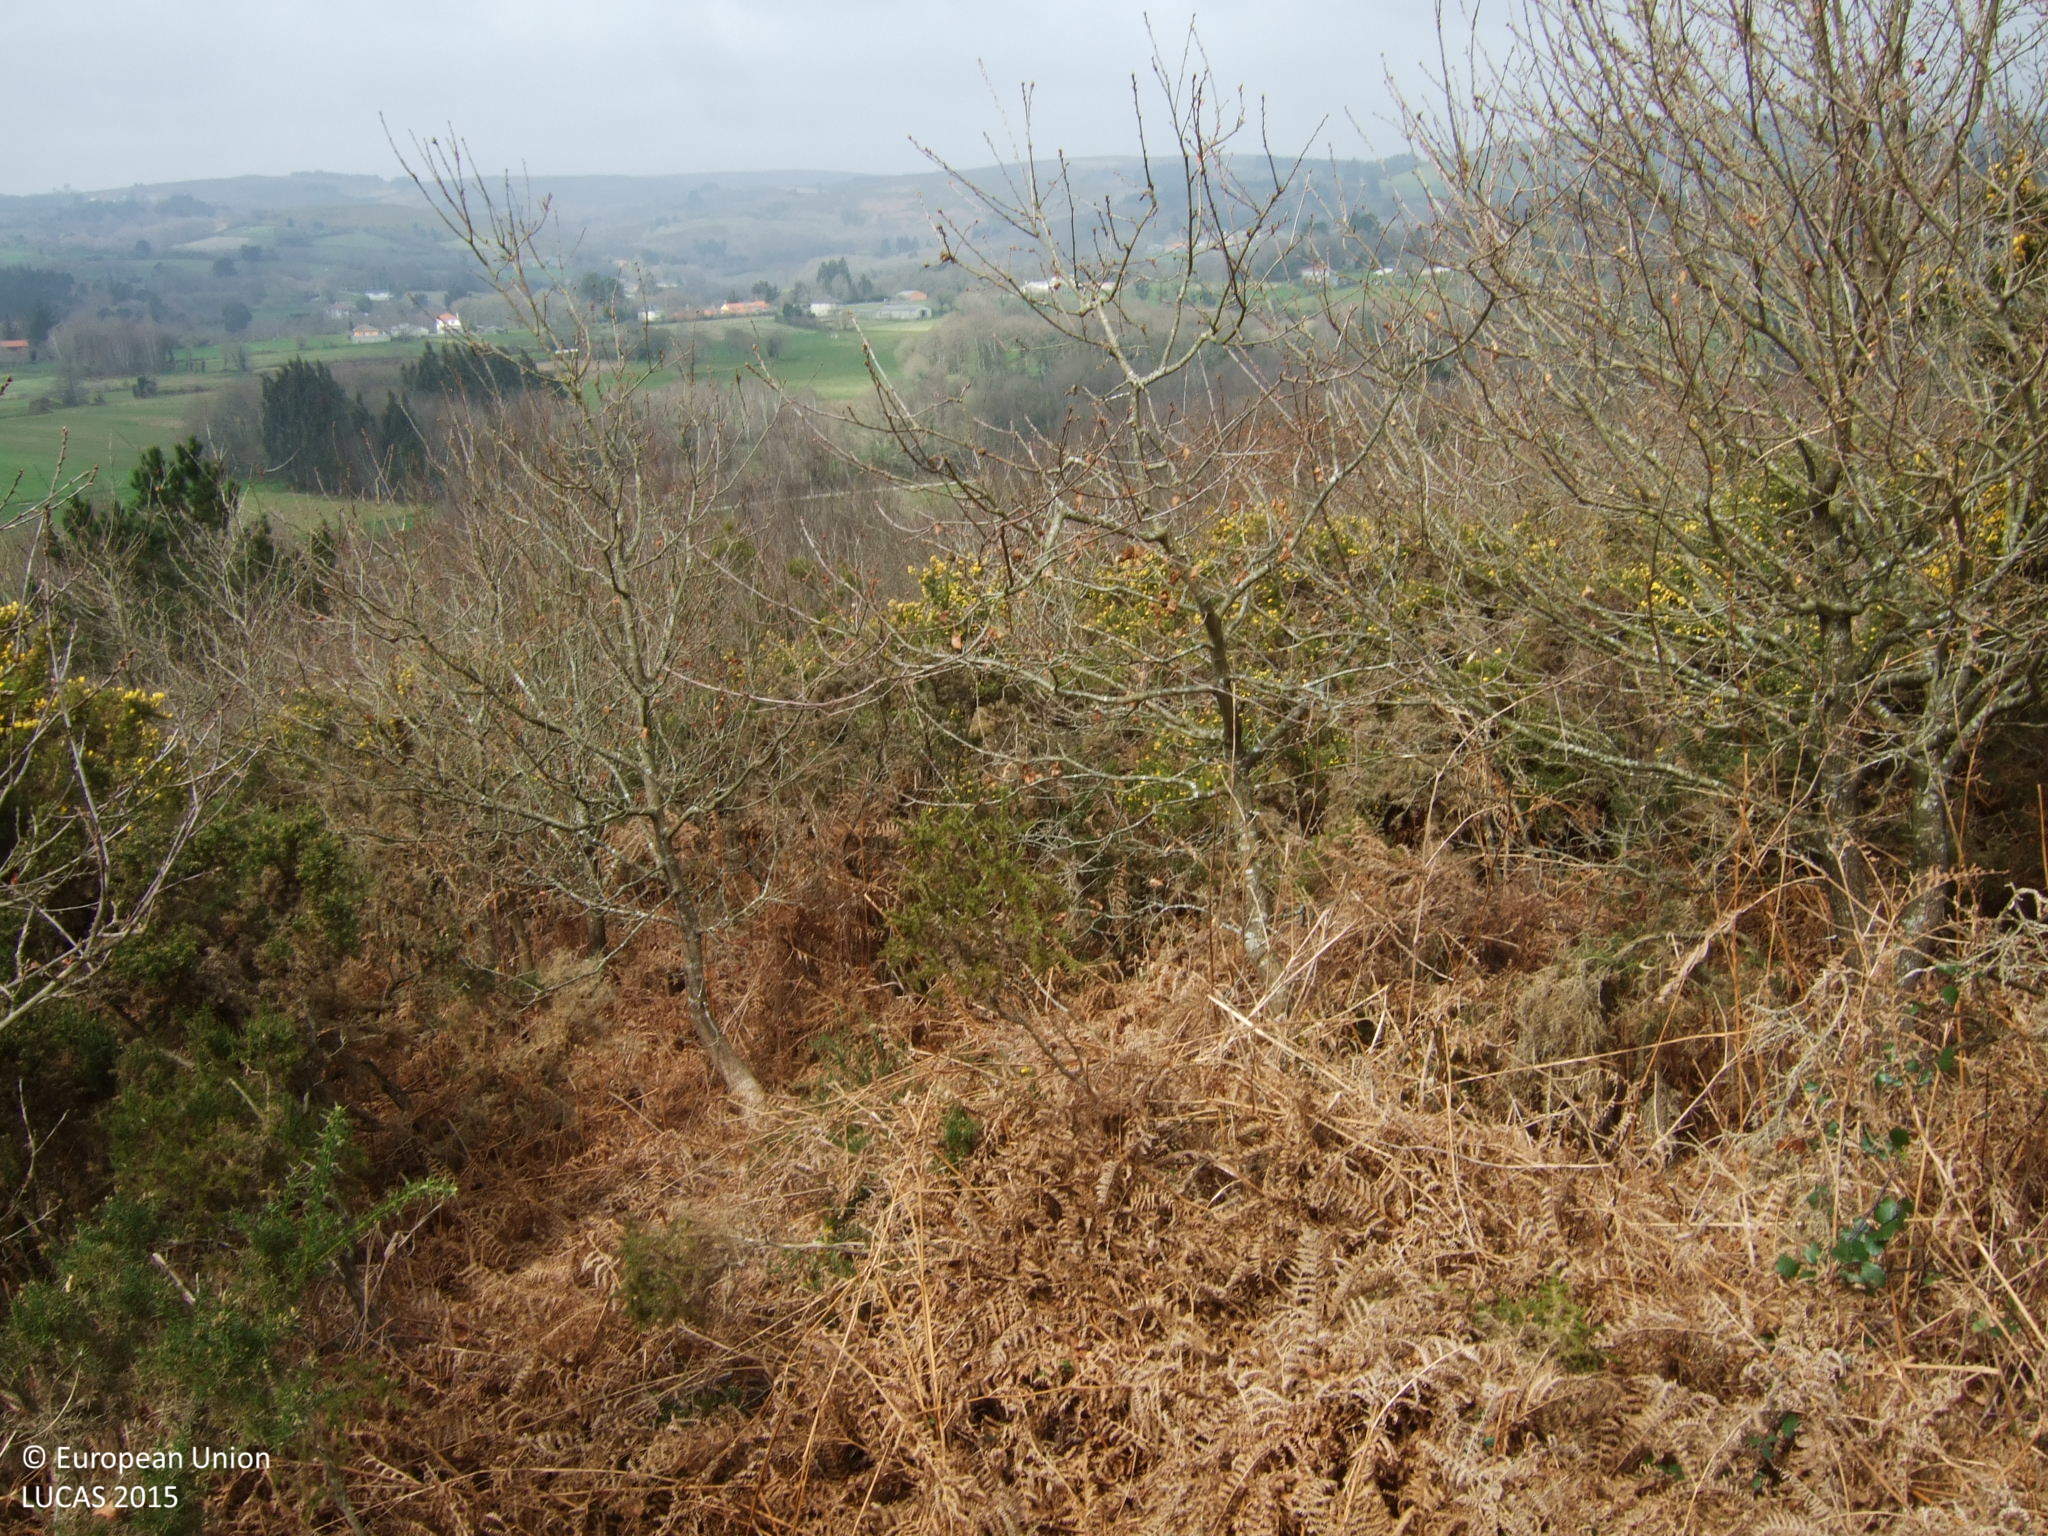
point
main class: Woodland
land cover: Broadleaved woodland
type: acidophilous oak and oak-birch forest
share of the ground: > 75 %
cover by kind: broadleaved forest trees 80 %, shrubs 20 %
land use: Semi-natural and natural areas not in use
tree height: > 5 m
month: March
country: ES
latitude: 42.9323
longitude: -7.8645
